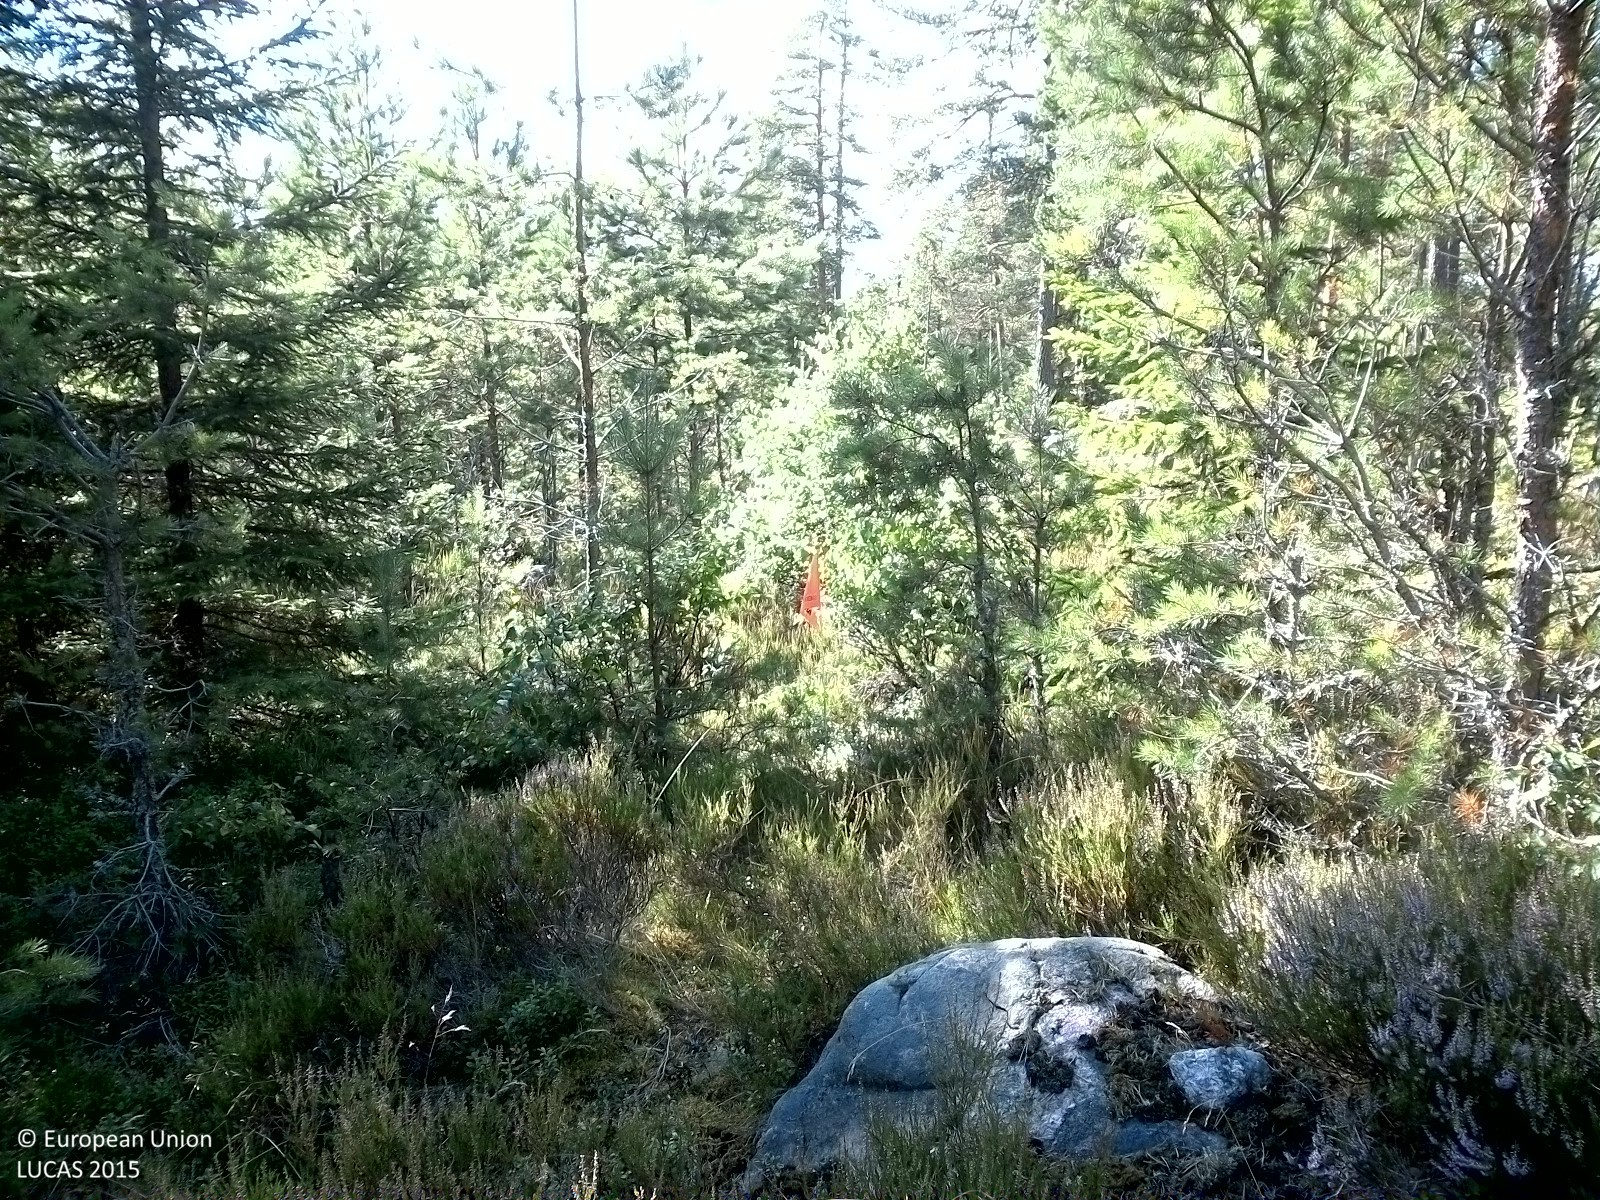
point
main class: Woodland
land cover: Pine dominated coniferous woodland
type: boreal forest
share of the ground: 50 - 75 %
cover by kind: coniferous forest trees 55 %, herbaceous plants 25 %, shrubs 15 %, lichens and mosses 5 %
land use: Forestry
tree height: < 5 m
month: August
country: SE
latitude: 58.9959
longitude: 15.3708
